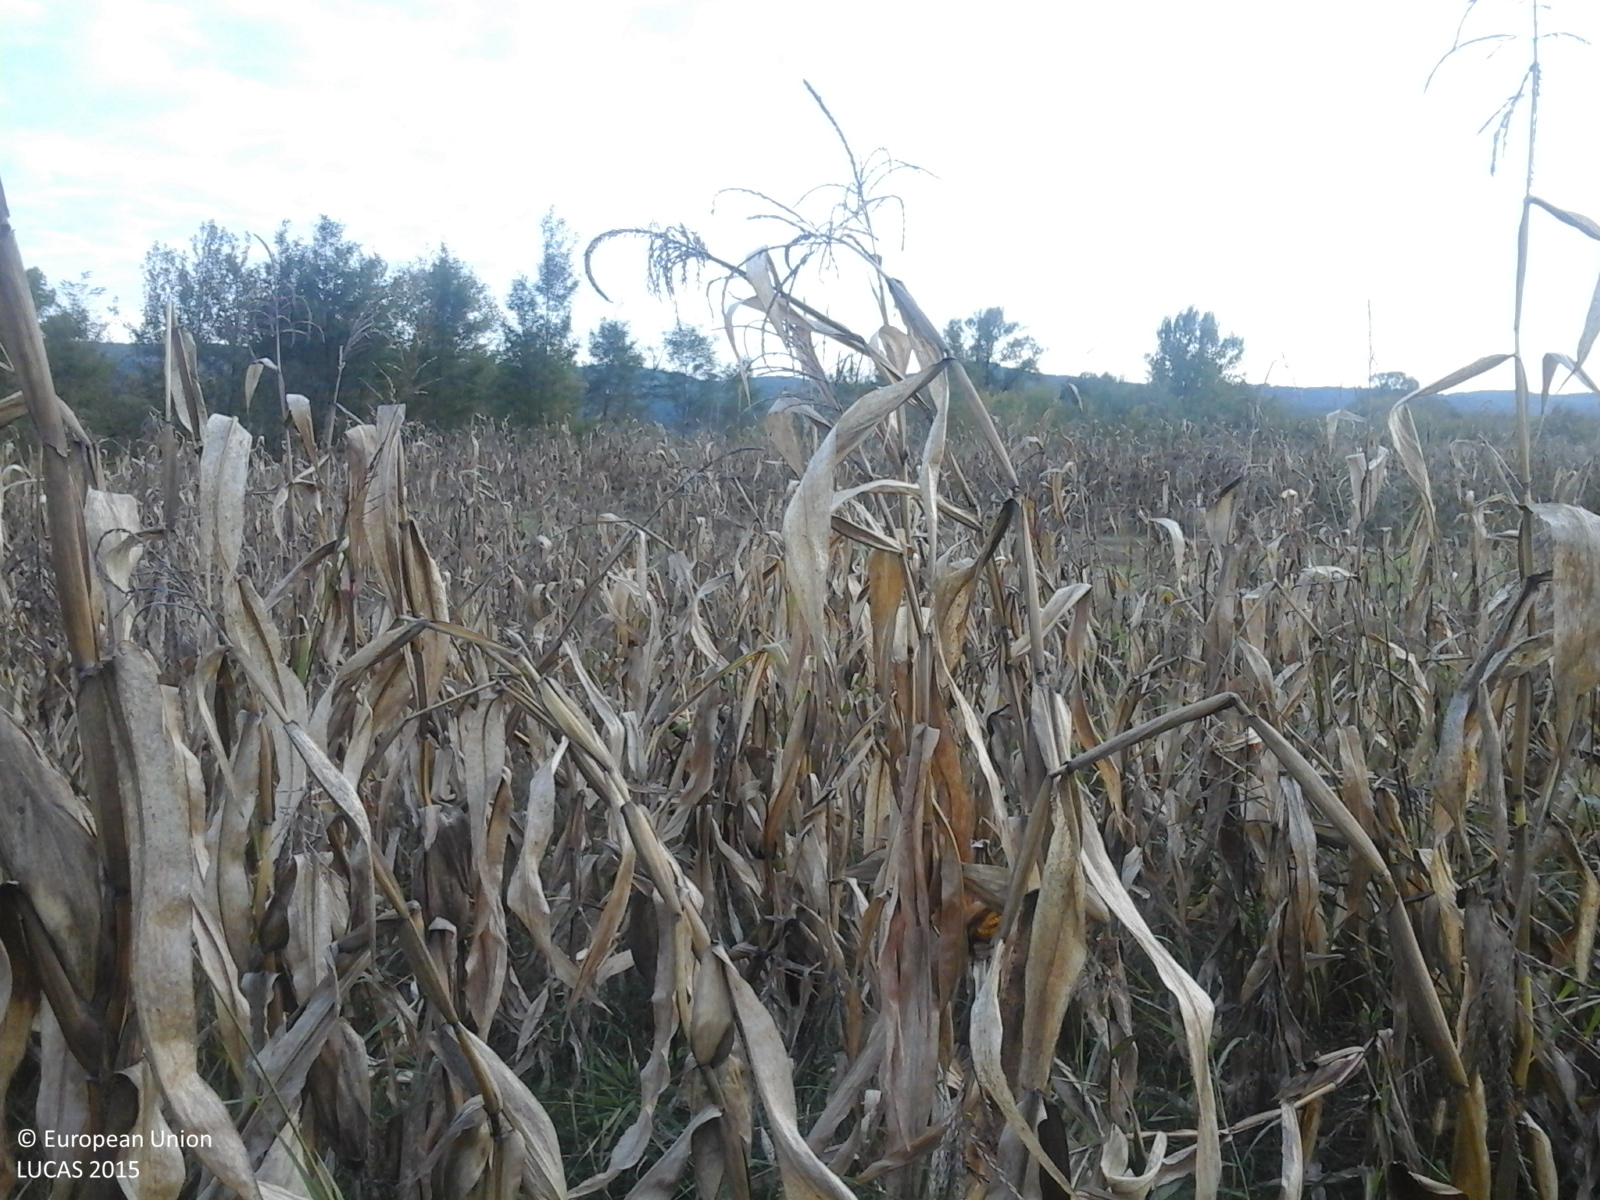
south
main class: Cropland
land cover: Maize
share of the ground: > 75 %
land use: Agriculture (excluding fallow land and kitchen gardens)
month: October
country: RO
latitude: 46.2145
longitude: 24.5124
